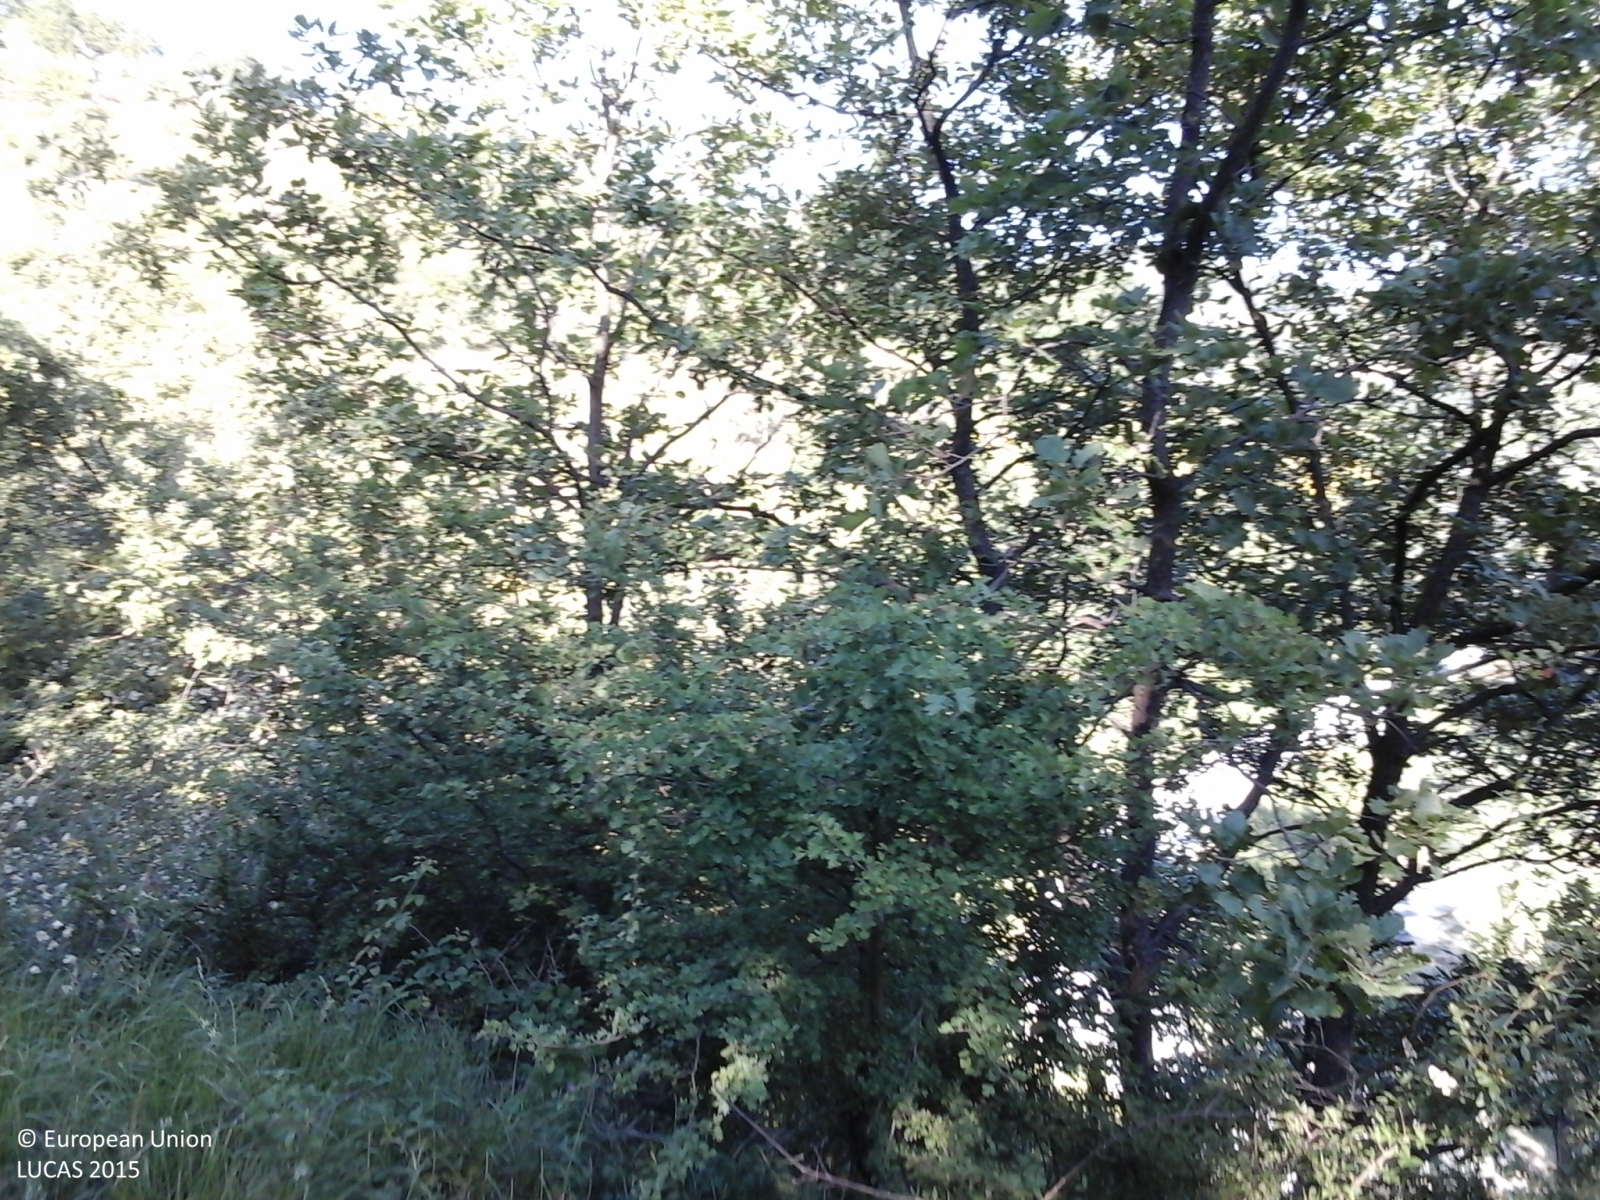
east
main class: Shrubland
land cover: Shrubland with sparse tree cover
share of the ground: > 75 %
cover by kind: shrubs 60 %, herbaceous plants 35 %, broadleaved forest trees 5 %
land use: Abandoned areas
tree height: < 5 m
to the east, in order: Shrubland with sparse tree cover; Dry stone walls; Shrubland with sparse tree cover; Dry stone walls; Olive groves; Dry stone walls; Olive groves; Dry stone walls; Shrubland with sparse tree cover; Dry stone walls; Shrubland with sparse tree cover; Dry stone walls; Shrubland with sparse tree cover; Broadleaved woodland; Grass margins; Paved roads, cycling and walking lanes; Grass margins; Broadleaved woodland
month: June
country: IT
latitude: 44.5699
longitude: 8.2282
